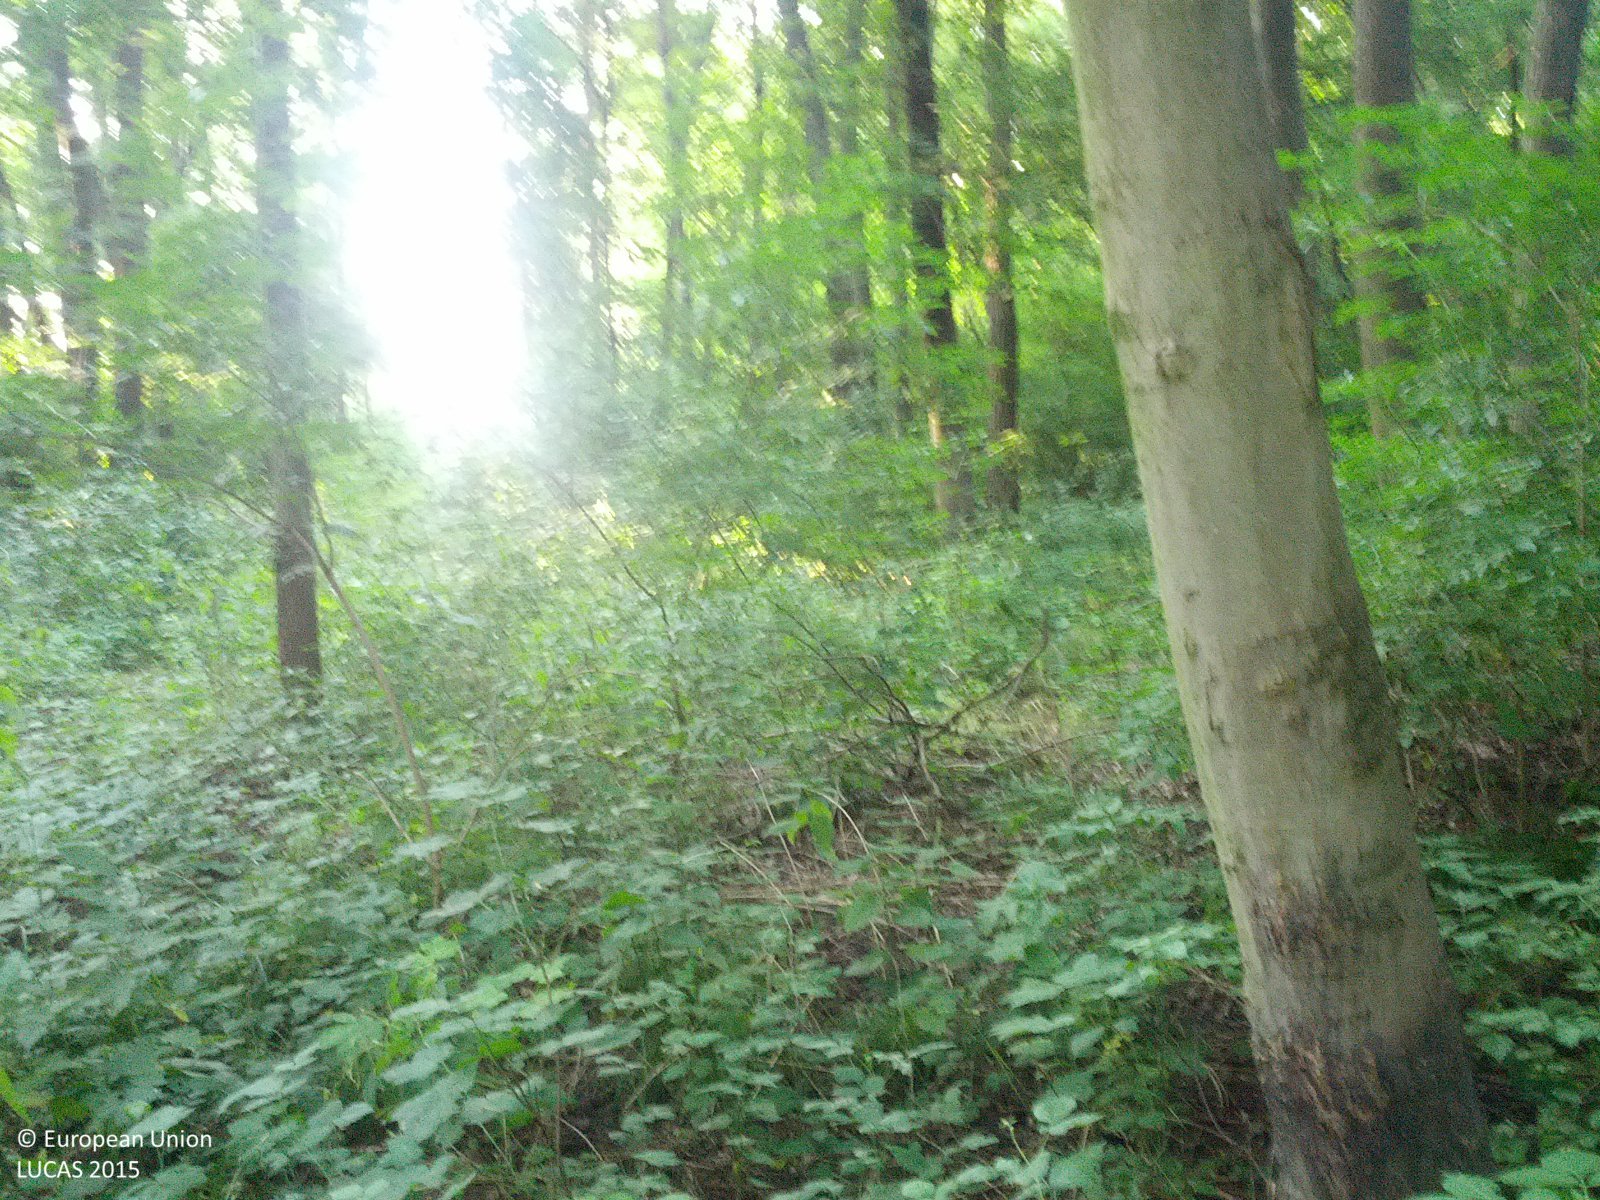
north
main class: Woodland
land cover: Broadleaved woodland
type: mesophytic deciduous forest
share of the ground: 50 - 75 %
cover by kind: broadleaved forest trees 60 %, shrubs 20 %, herbaceous plants 20 %
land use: Forestry
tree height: > 5 m
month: July
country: AT
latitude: 48.5979
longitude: 16.6919
